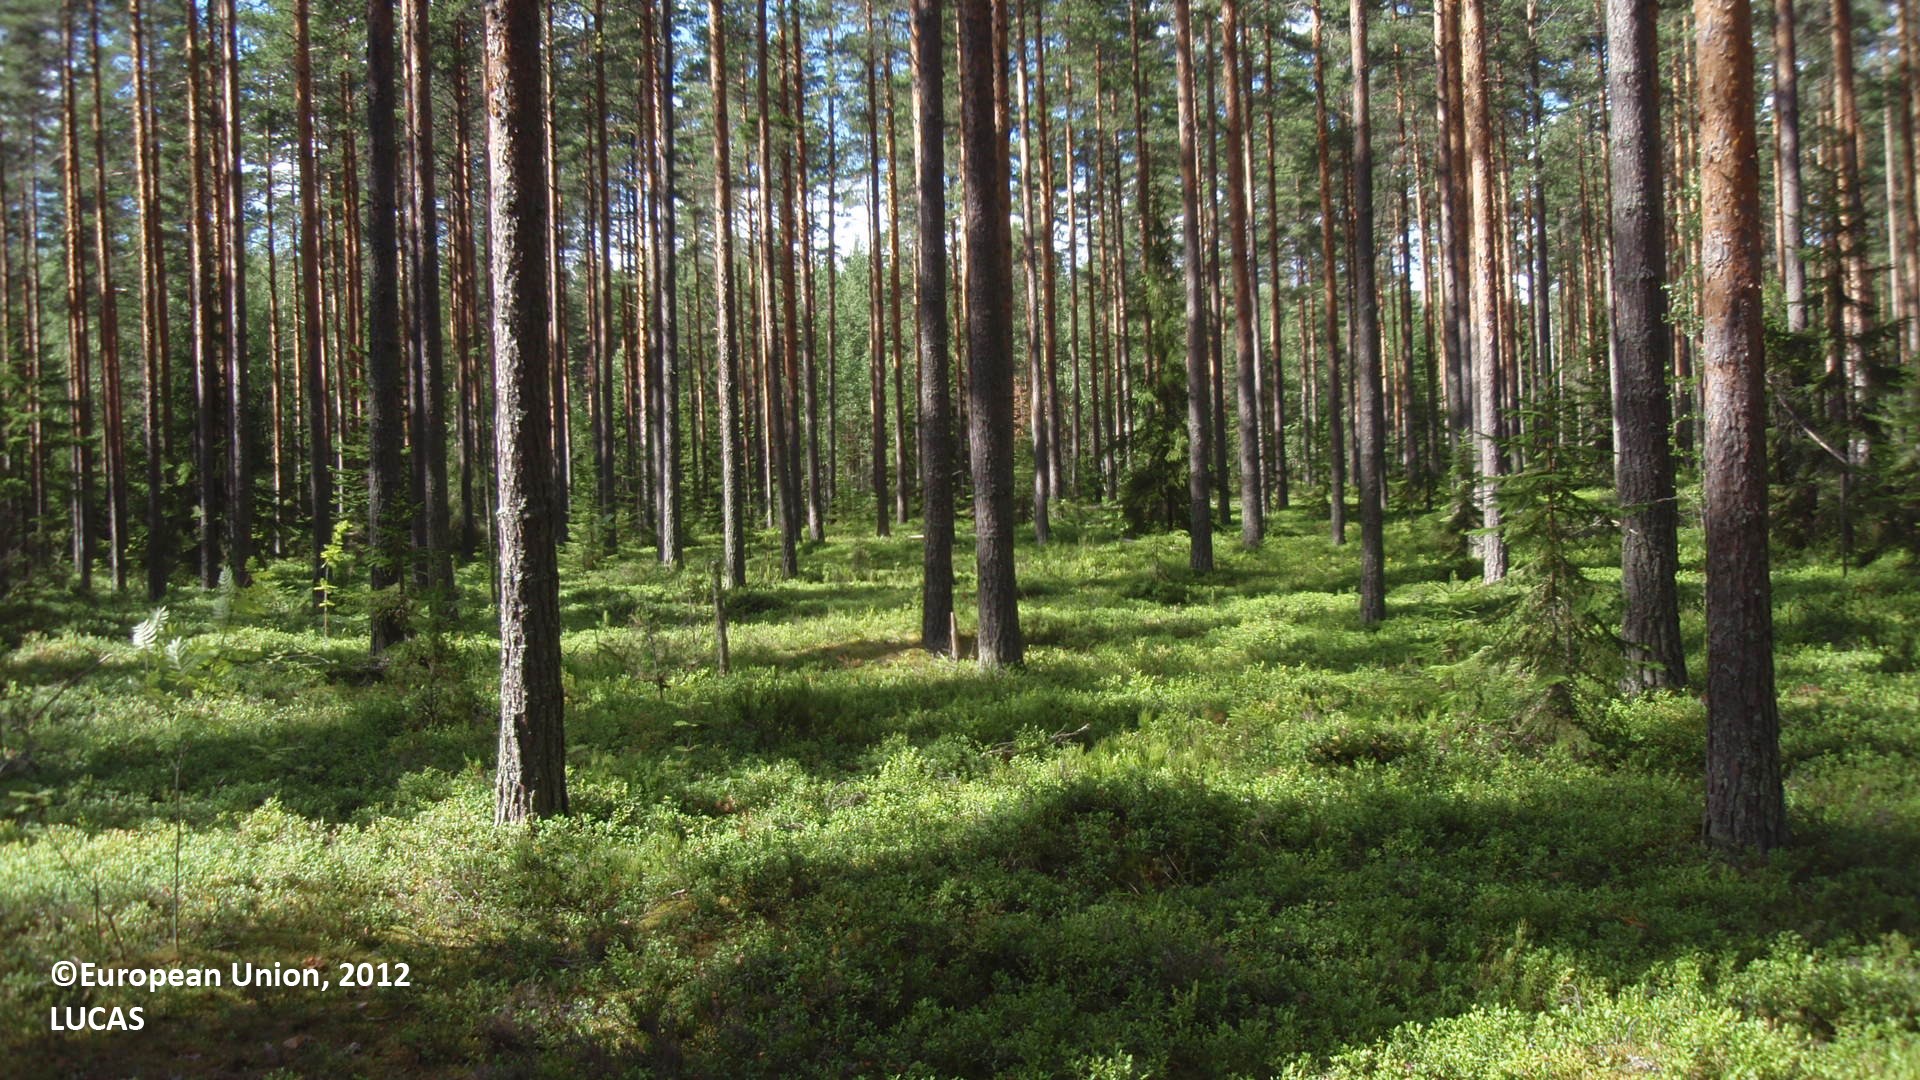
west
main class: Woodland
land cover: Pine dominated coniferous woodland
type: boreal forest
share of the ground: 25 - 50 %
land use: Forestry
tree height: > 5 m
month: July
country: FI
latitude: 61.6618
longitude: 27.8447
